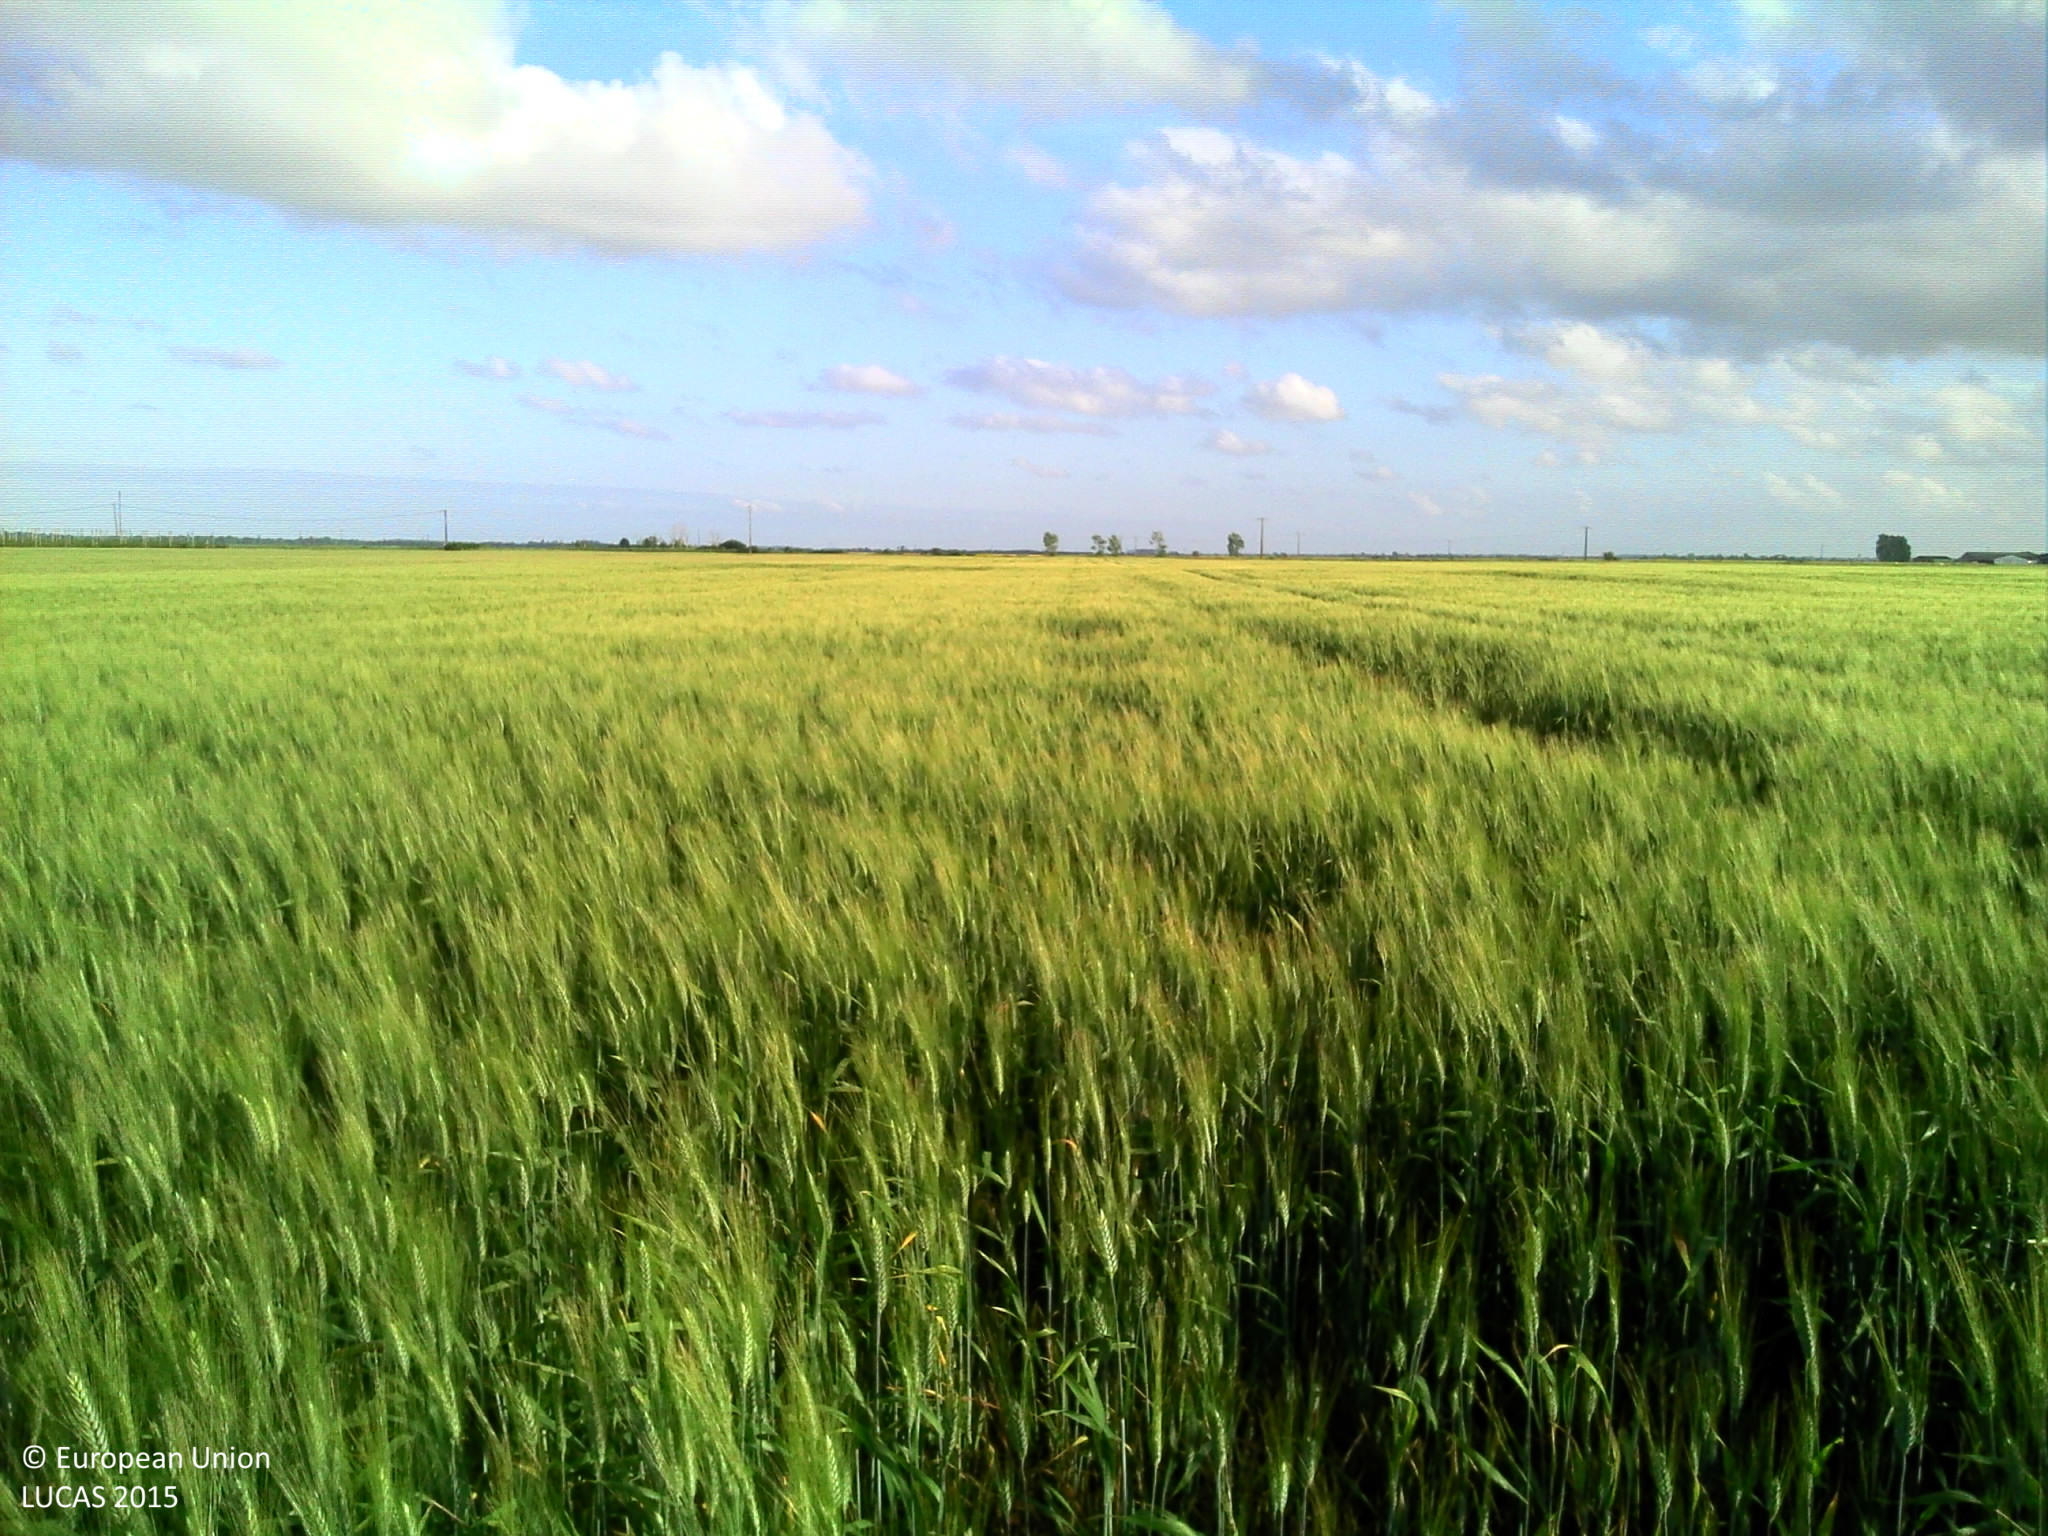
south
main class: Cropland
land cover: Common wheat
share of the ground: > 75 %
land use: Agriculture (excluding fallow land and kitchen gardens)
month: June
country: FR
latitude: 46.3033
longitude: -1.0545
